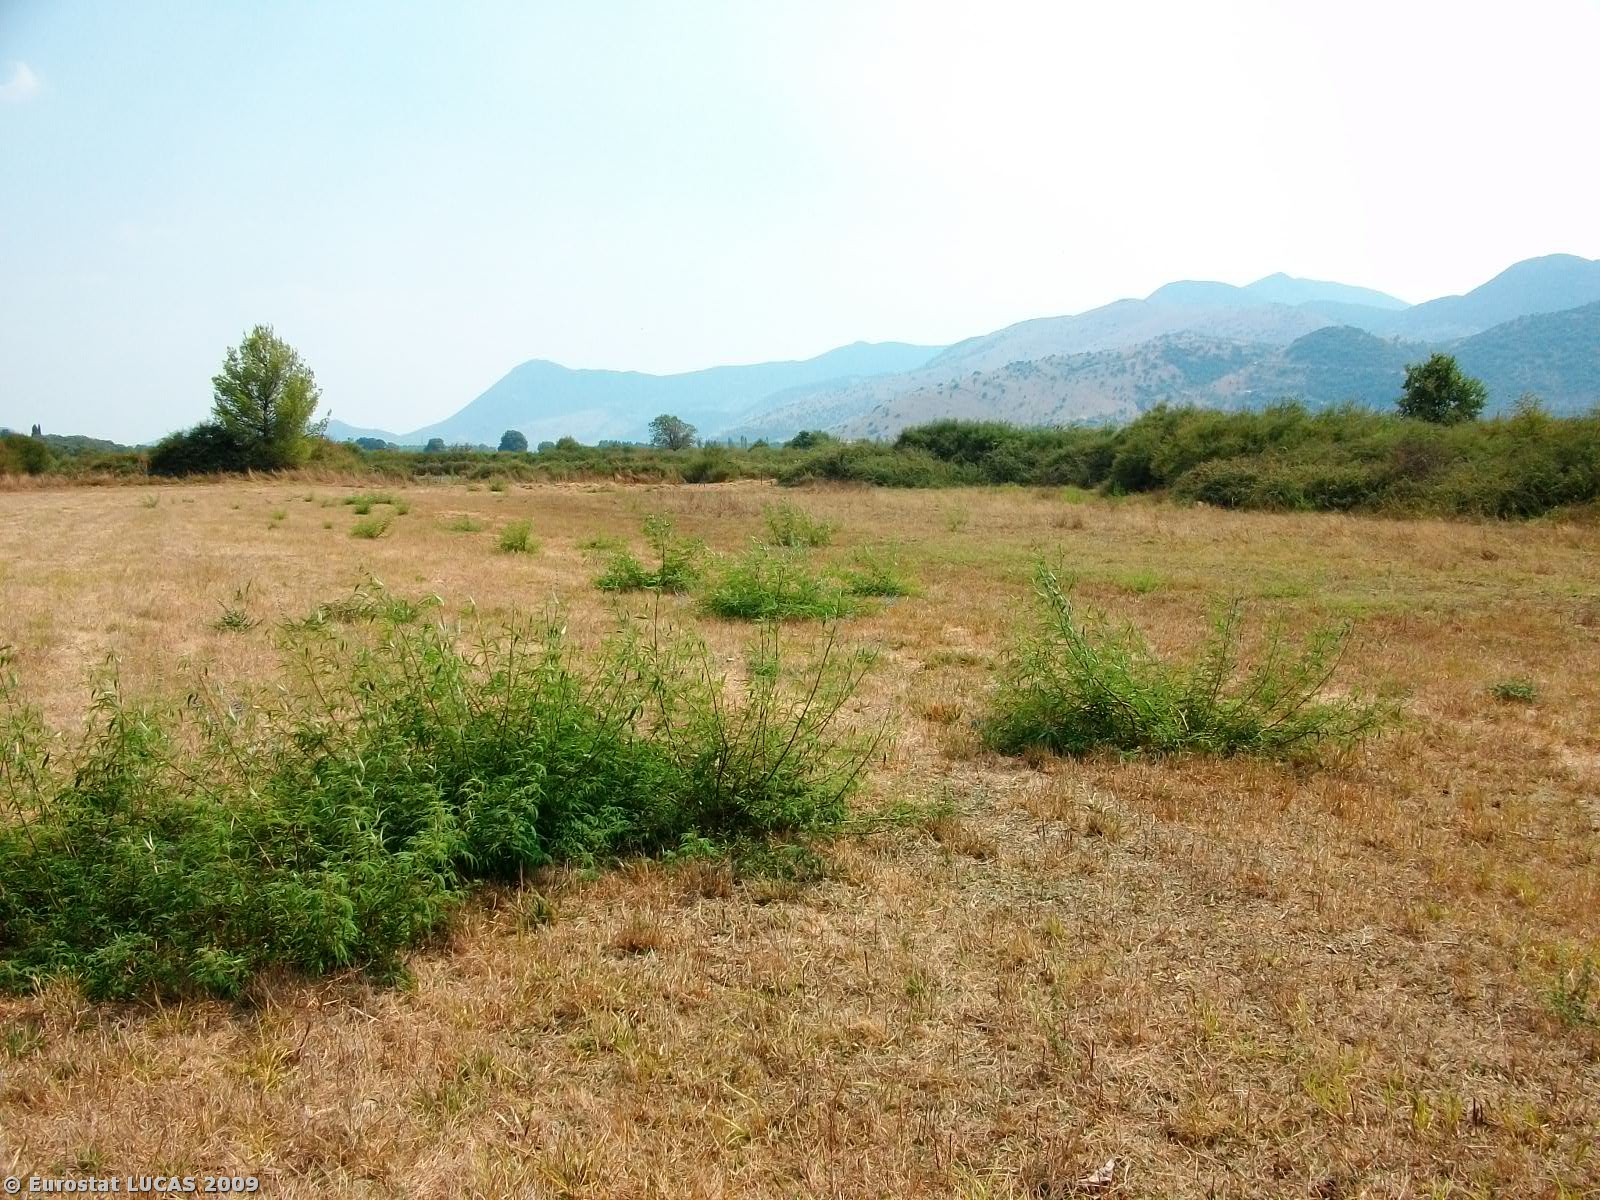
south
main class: Grassland
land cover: Grassland with sparse tree/shrub cover
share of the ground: > 75 %
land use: Agriculture (excluding fallow land and kitchen gardens)
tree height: < 5 m
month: August
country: GR
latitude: 39.3837
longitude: 20.4104
